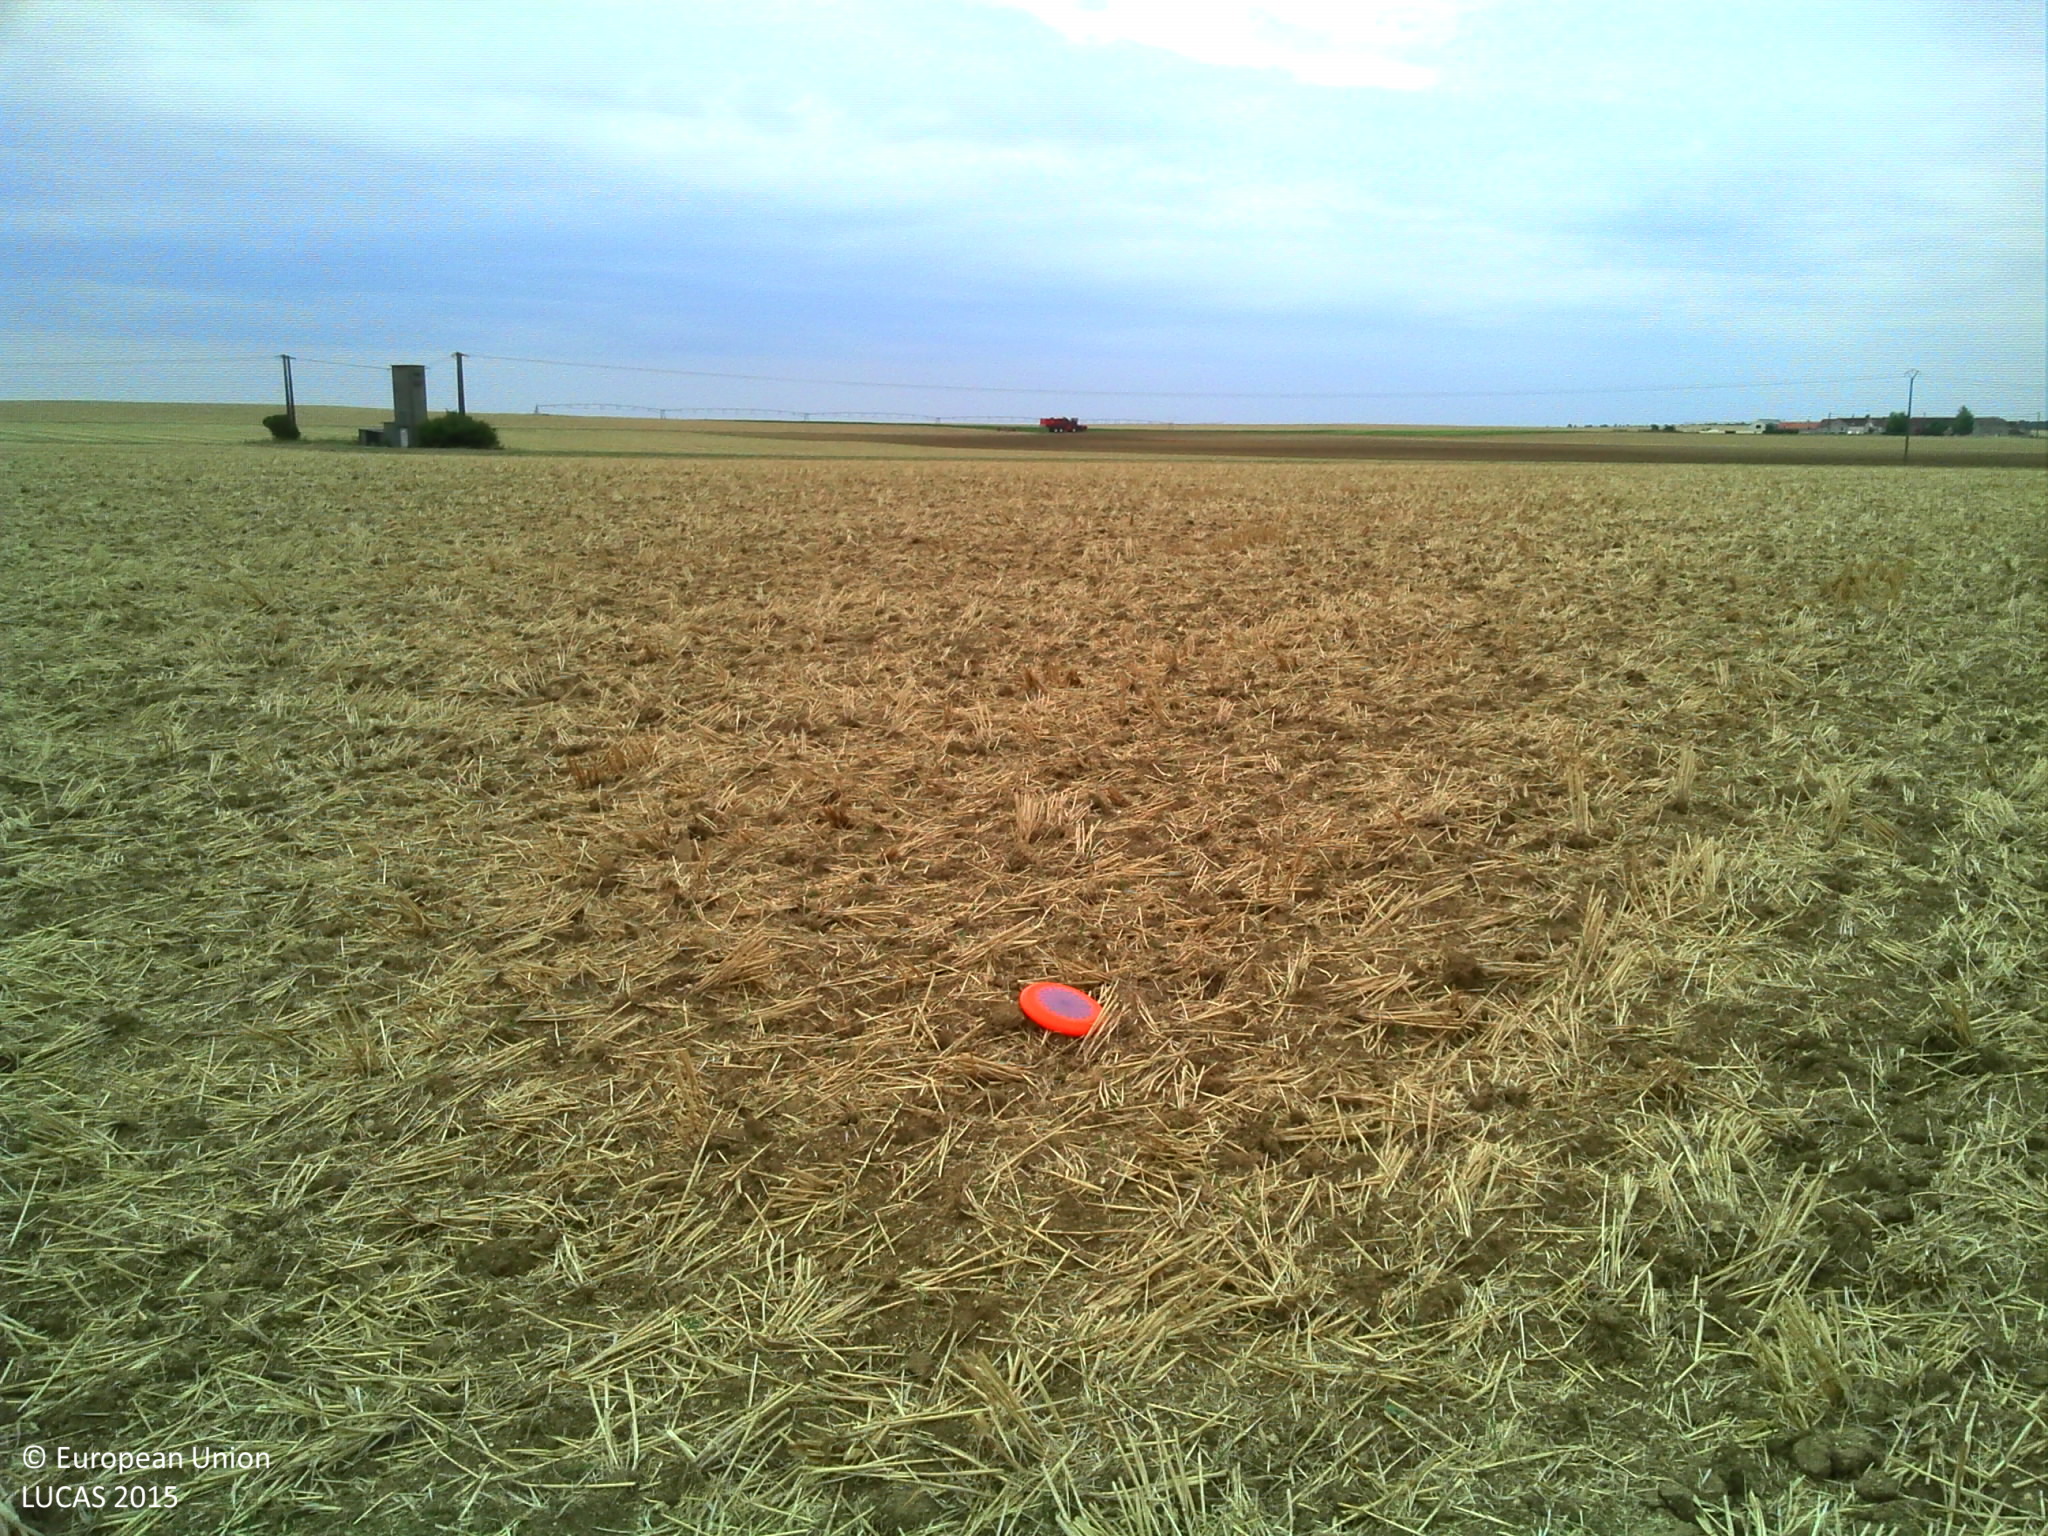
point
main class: Cropland
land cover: Common wheat
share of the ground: > 75 %
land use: Agriculture (excluding fallow land and kitchen gardens)
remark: Harvested field
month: August
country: FR
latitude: 48.1525
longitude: 2.5569
